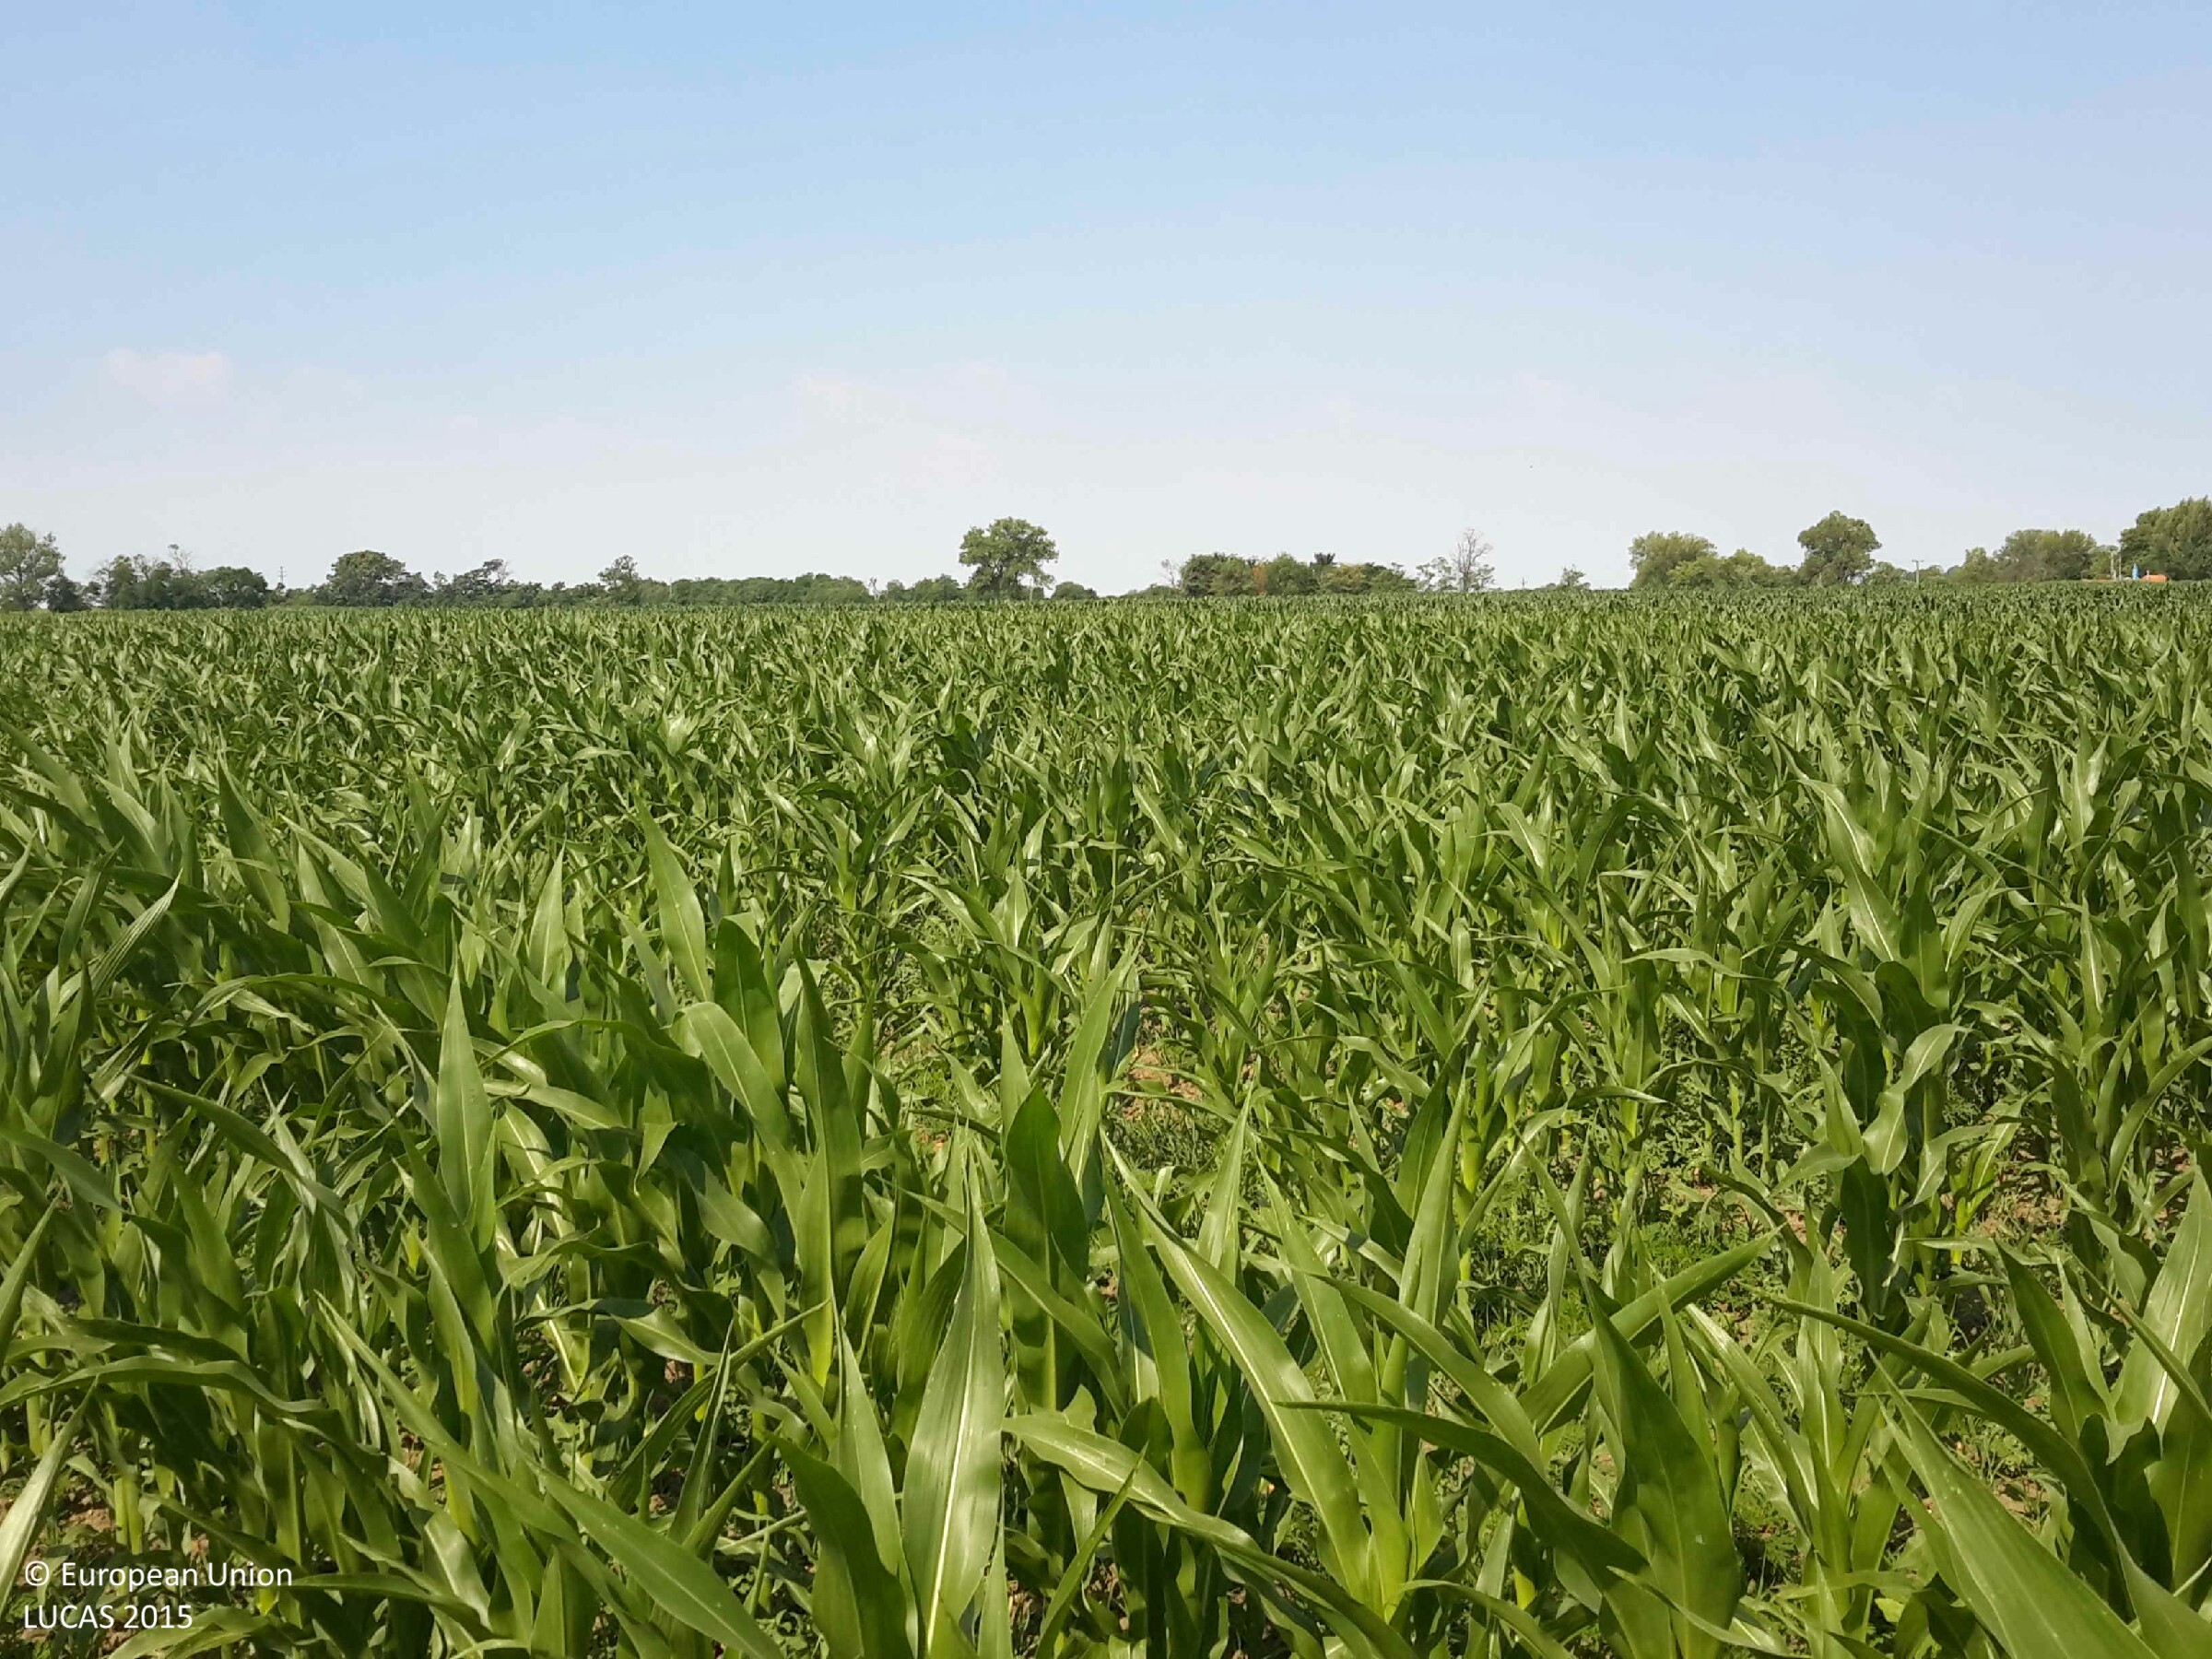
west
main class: Cropland
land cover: Maize
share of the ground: > 75 %
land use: Agriculture (excluding fallow land and kitchen gardens)
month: July
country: HU
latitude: 47.3668
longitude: 17.3030
